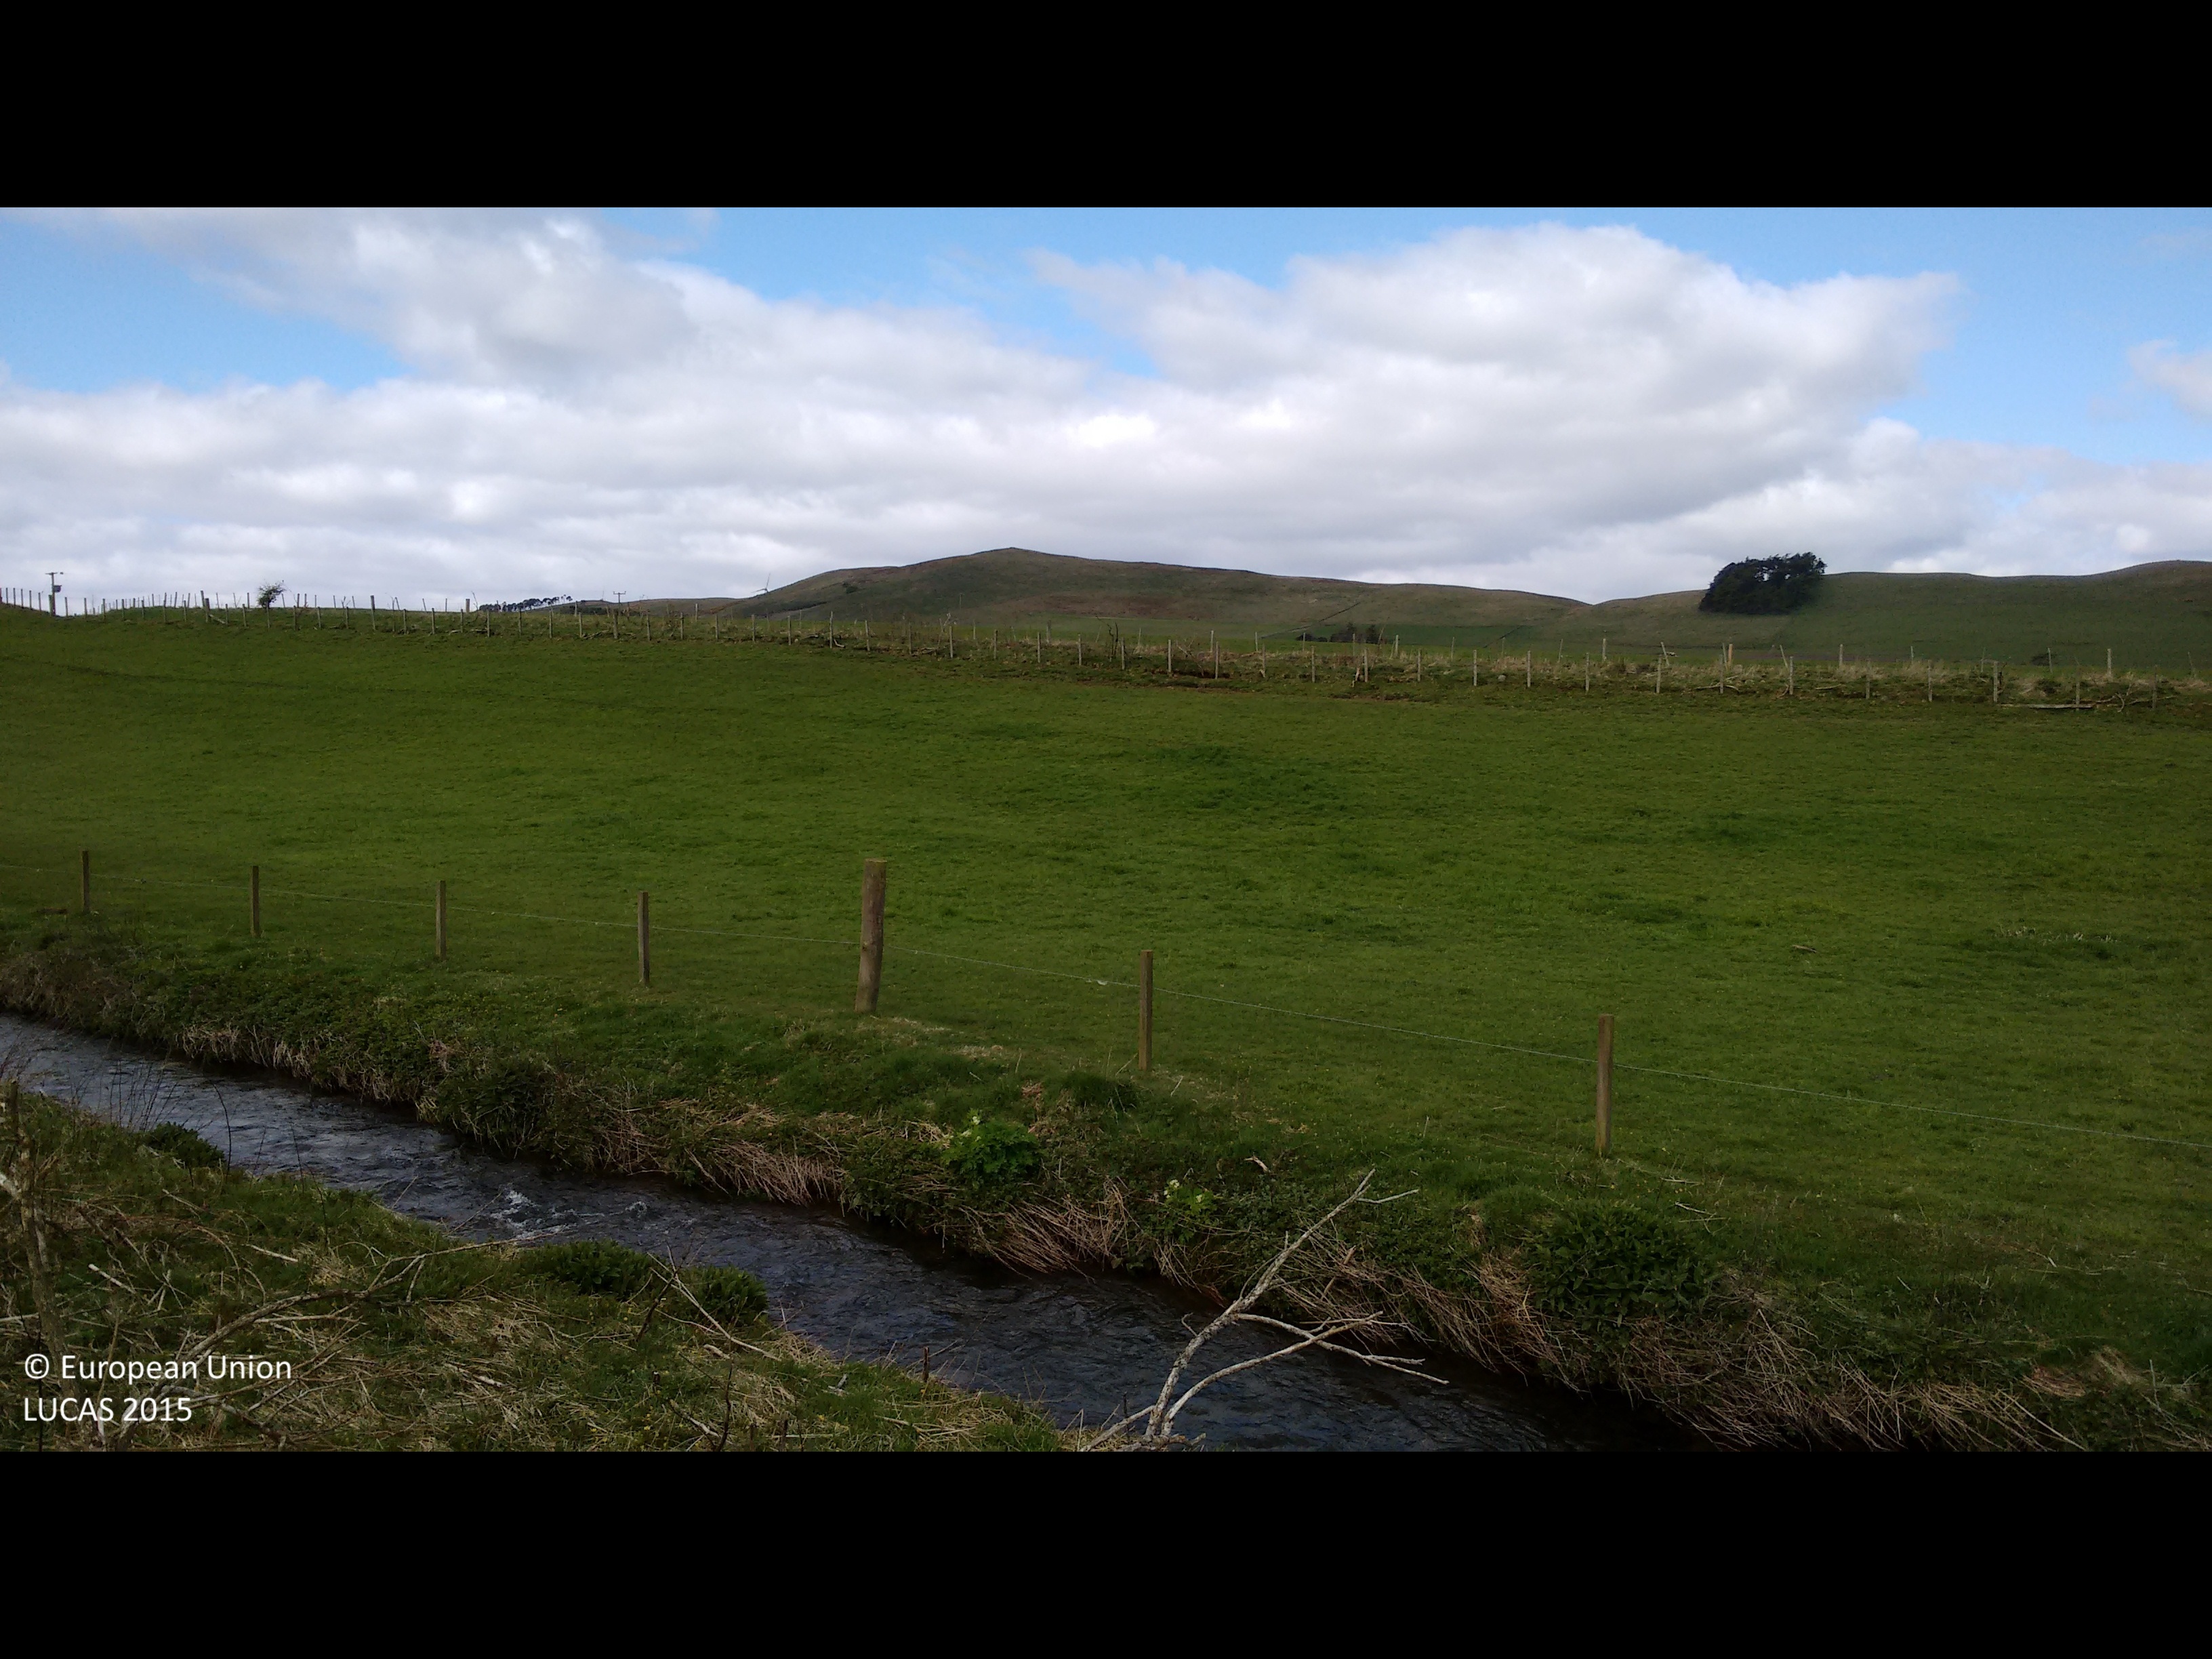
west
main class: Shrubland
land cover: Shrubland without tree cover
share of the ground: 50 - 75 %
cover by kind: herbaceous plants 60 %, shrubs 40 %
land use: Semi-natural and natural areas not in use
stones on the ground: 10 - 25 %
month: May
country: GB
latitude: 56.5800
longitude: -3.0079
